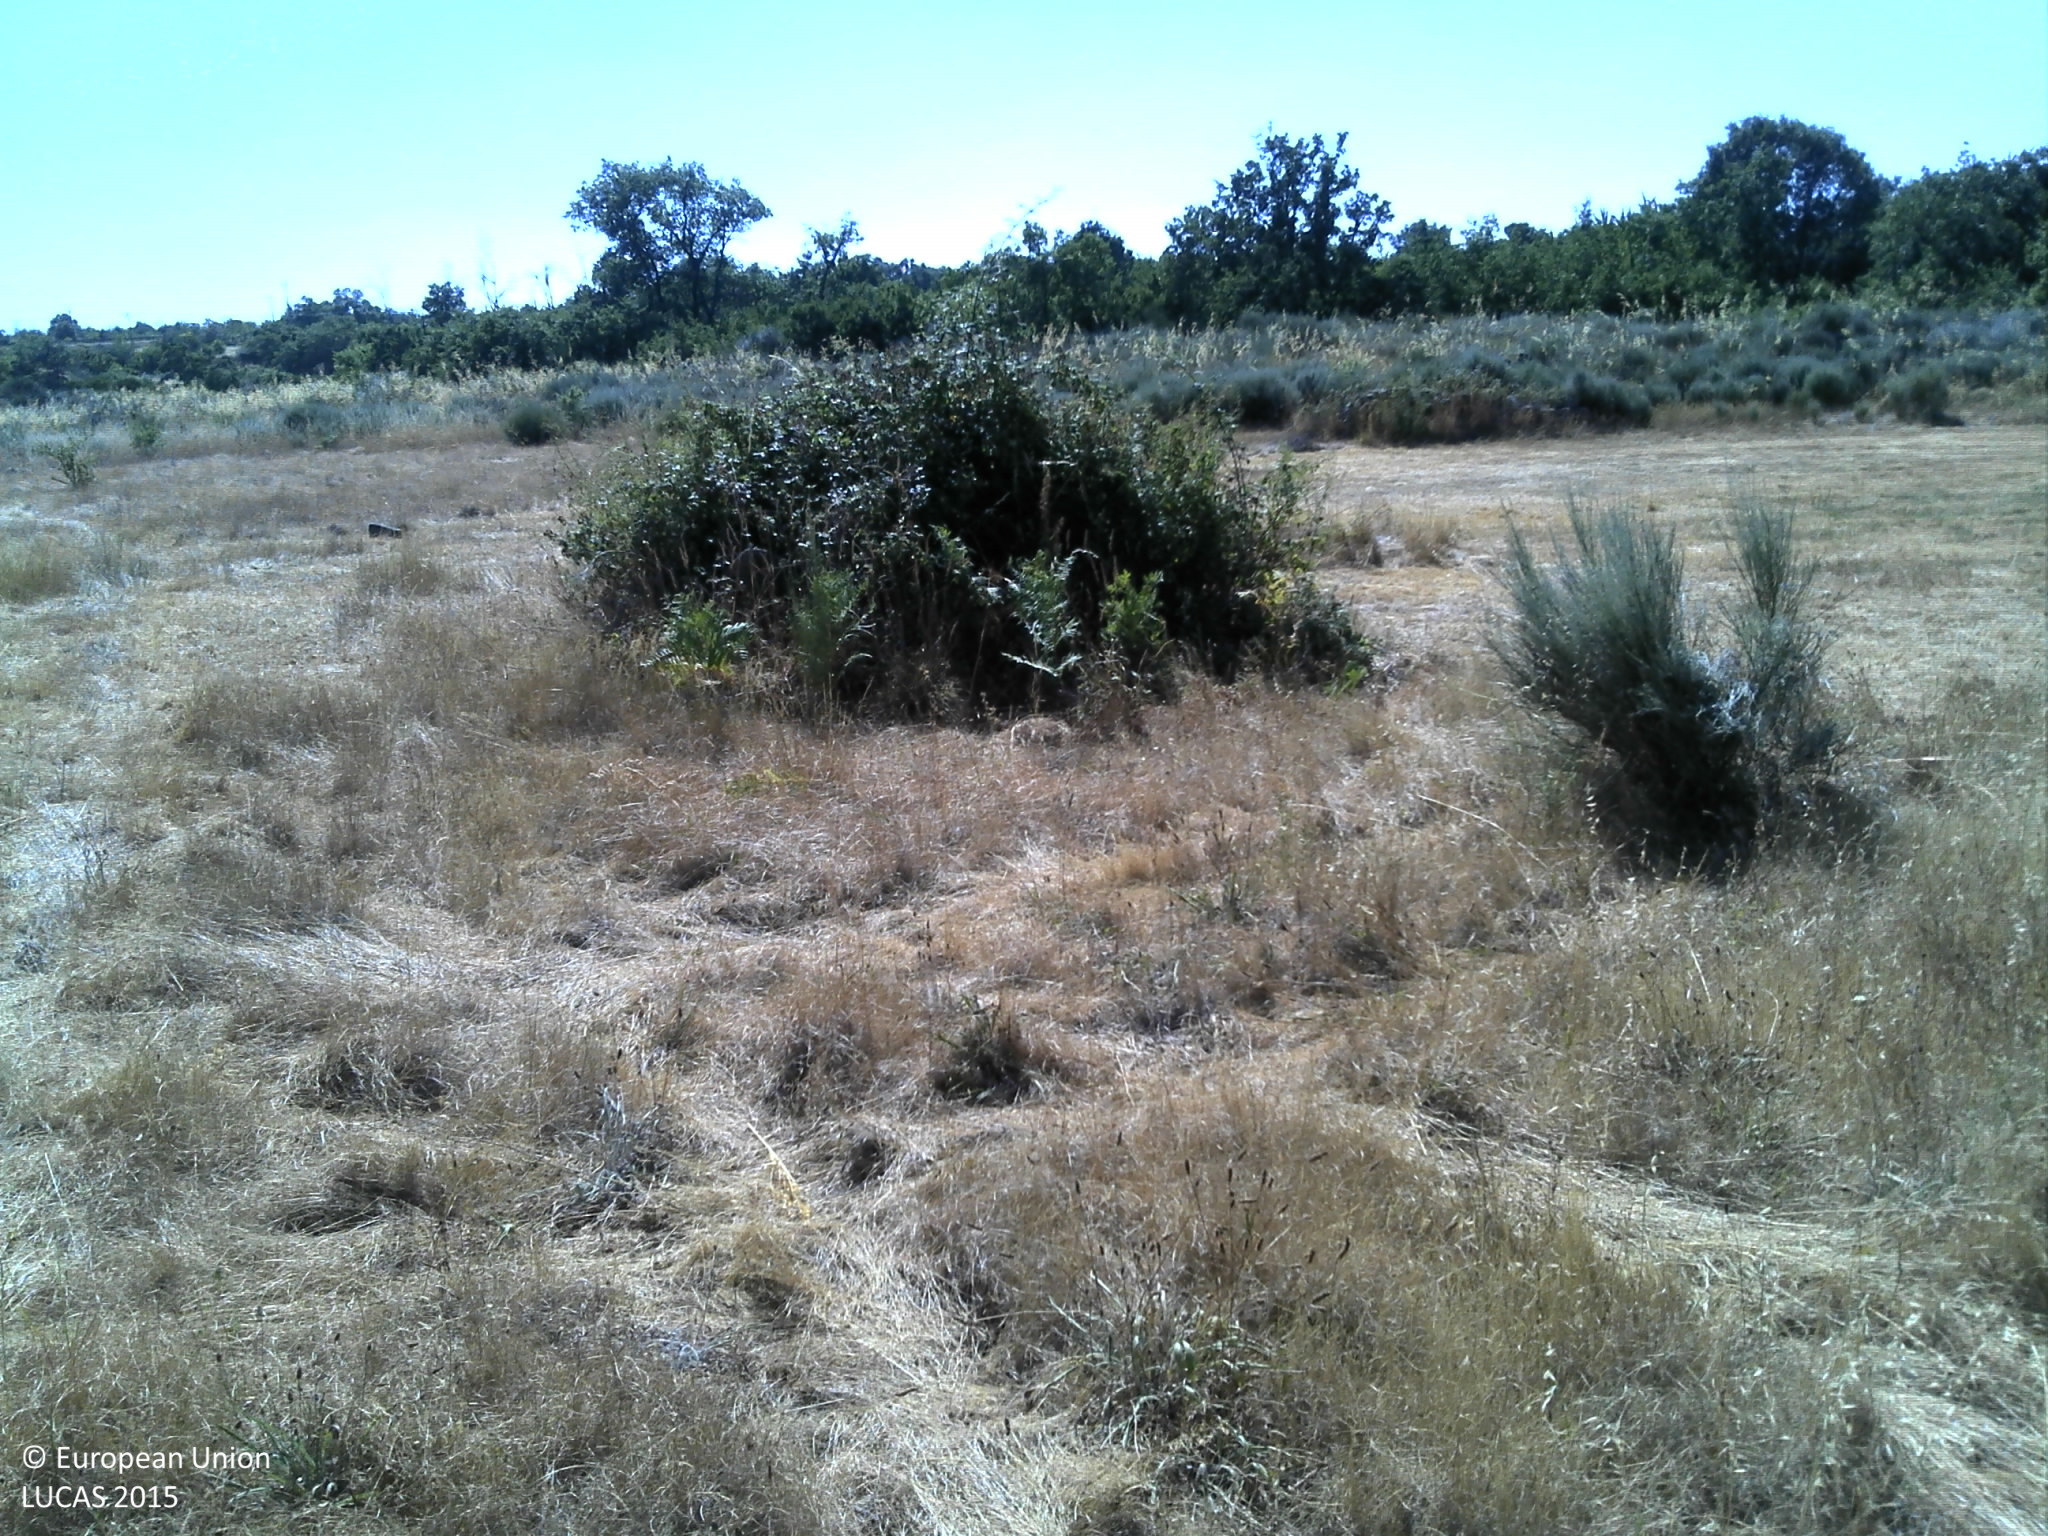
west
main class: Grassland
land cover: Grassland without tree/shrub cover
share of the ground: > 75 %
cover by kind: herbaceous plants 95 %, shrubs 5 %
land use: Agriculture (excluding fallow land and kitchen gardens)
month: July
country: PT
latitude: 40.9704
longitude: -7.2845
